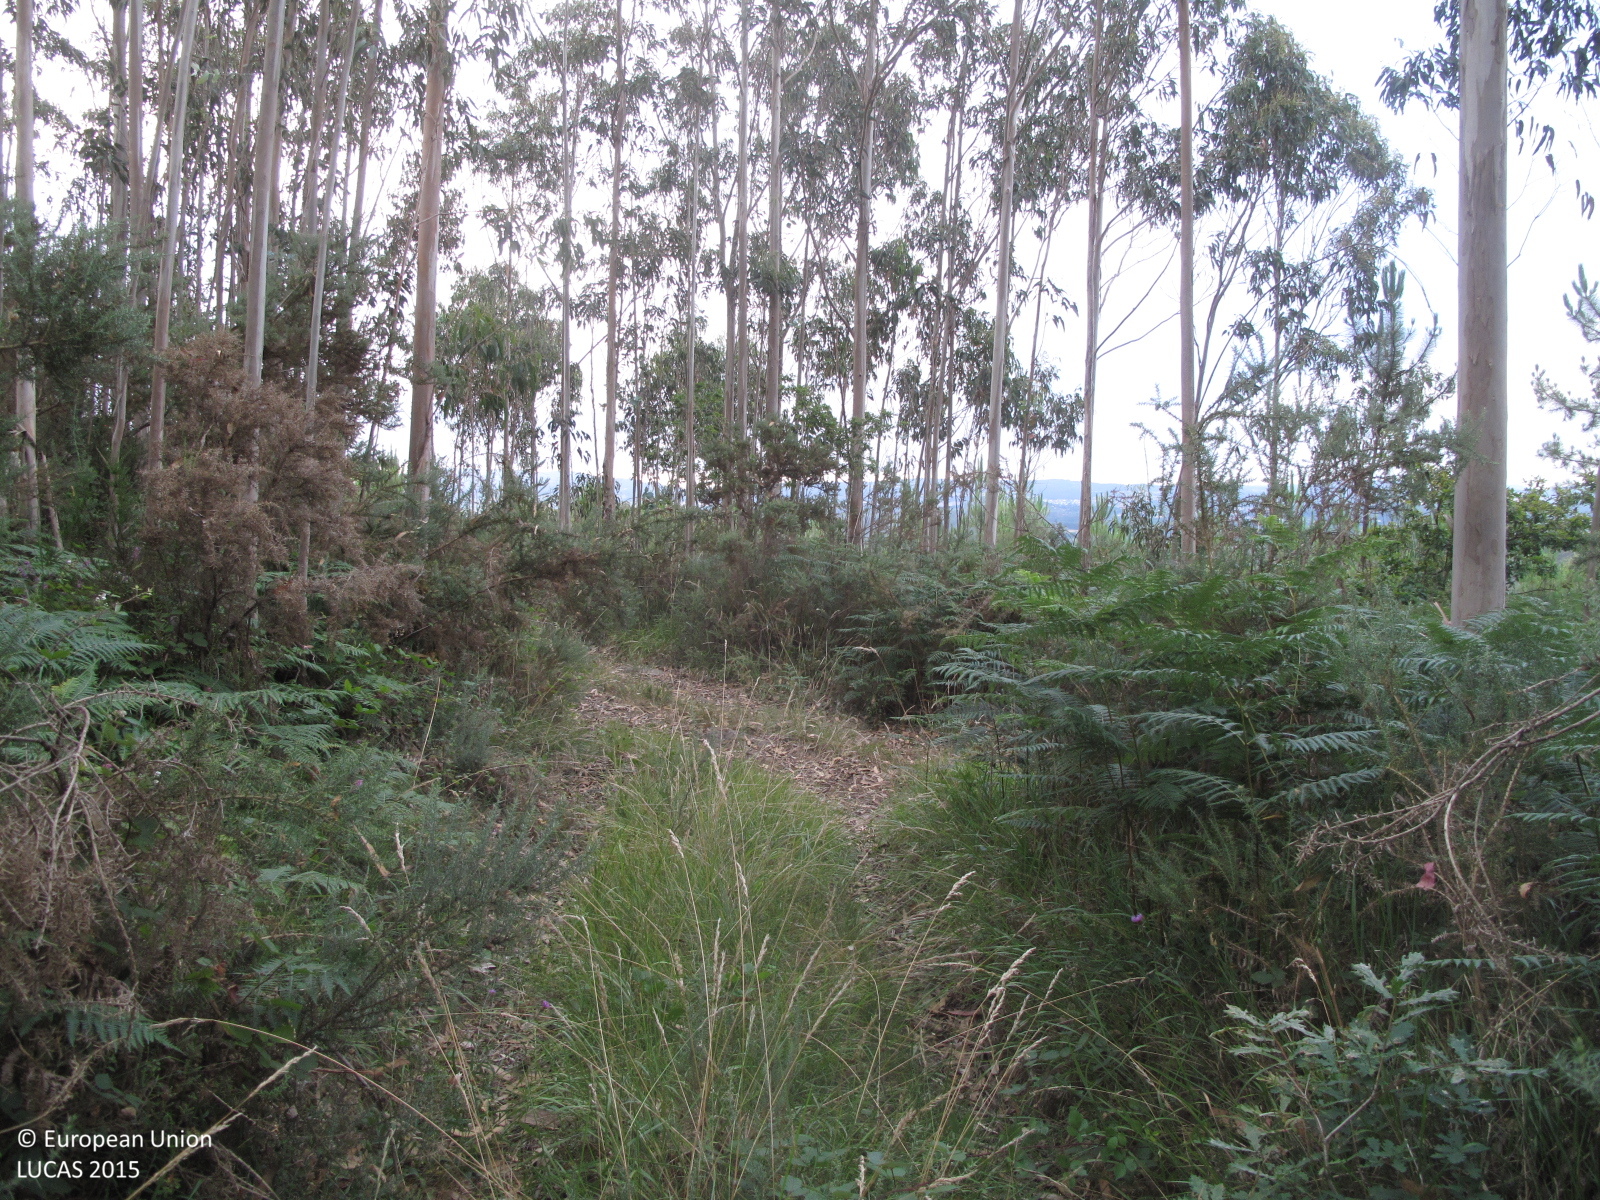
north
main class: Woodland
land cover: Broadleaved woodland
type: exotic forest
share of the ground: 25 - 50 %
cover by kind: shrubs 50 %, broadleaved forest trees 30 %, herbaceous plants 20 %
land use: Forestry
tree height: > 5 m
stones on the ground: < 10 %
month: July
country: ES
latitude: 43.1459
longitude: -8.7175
